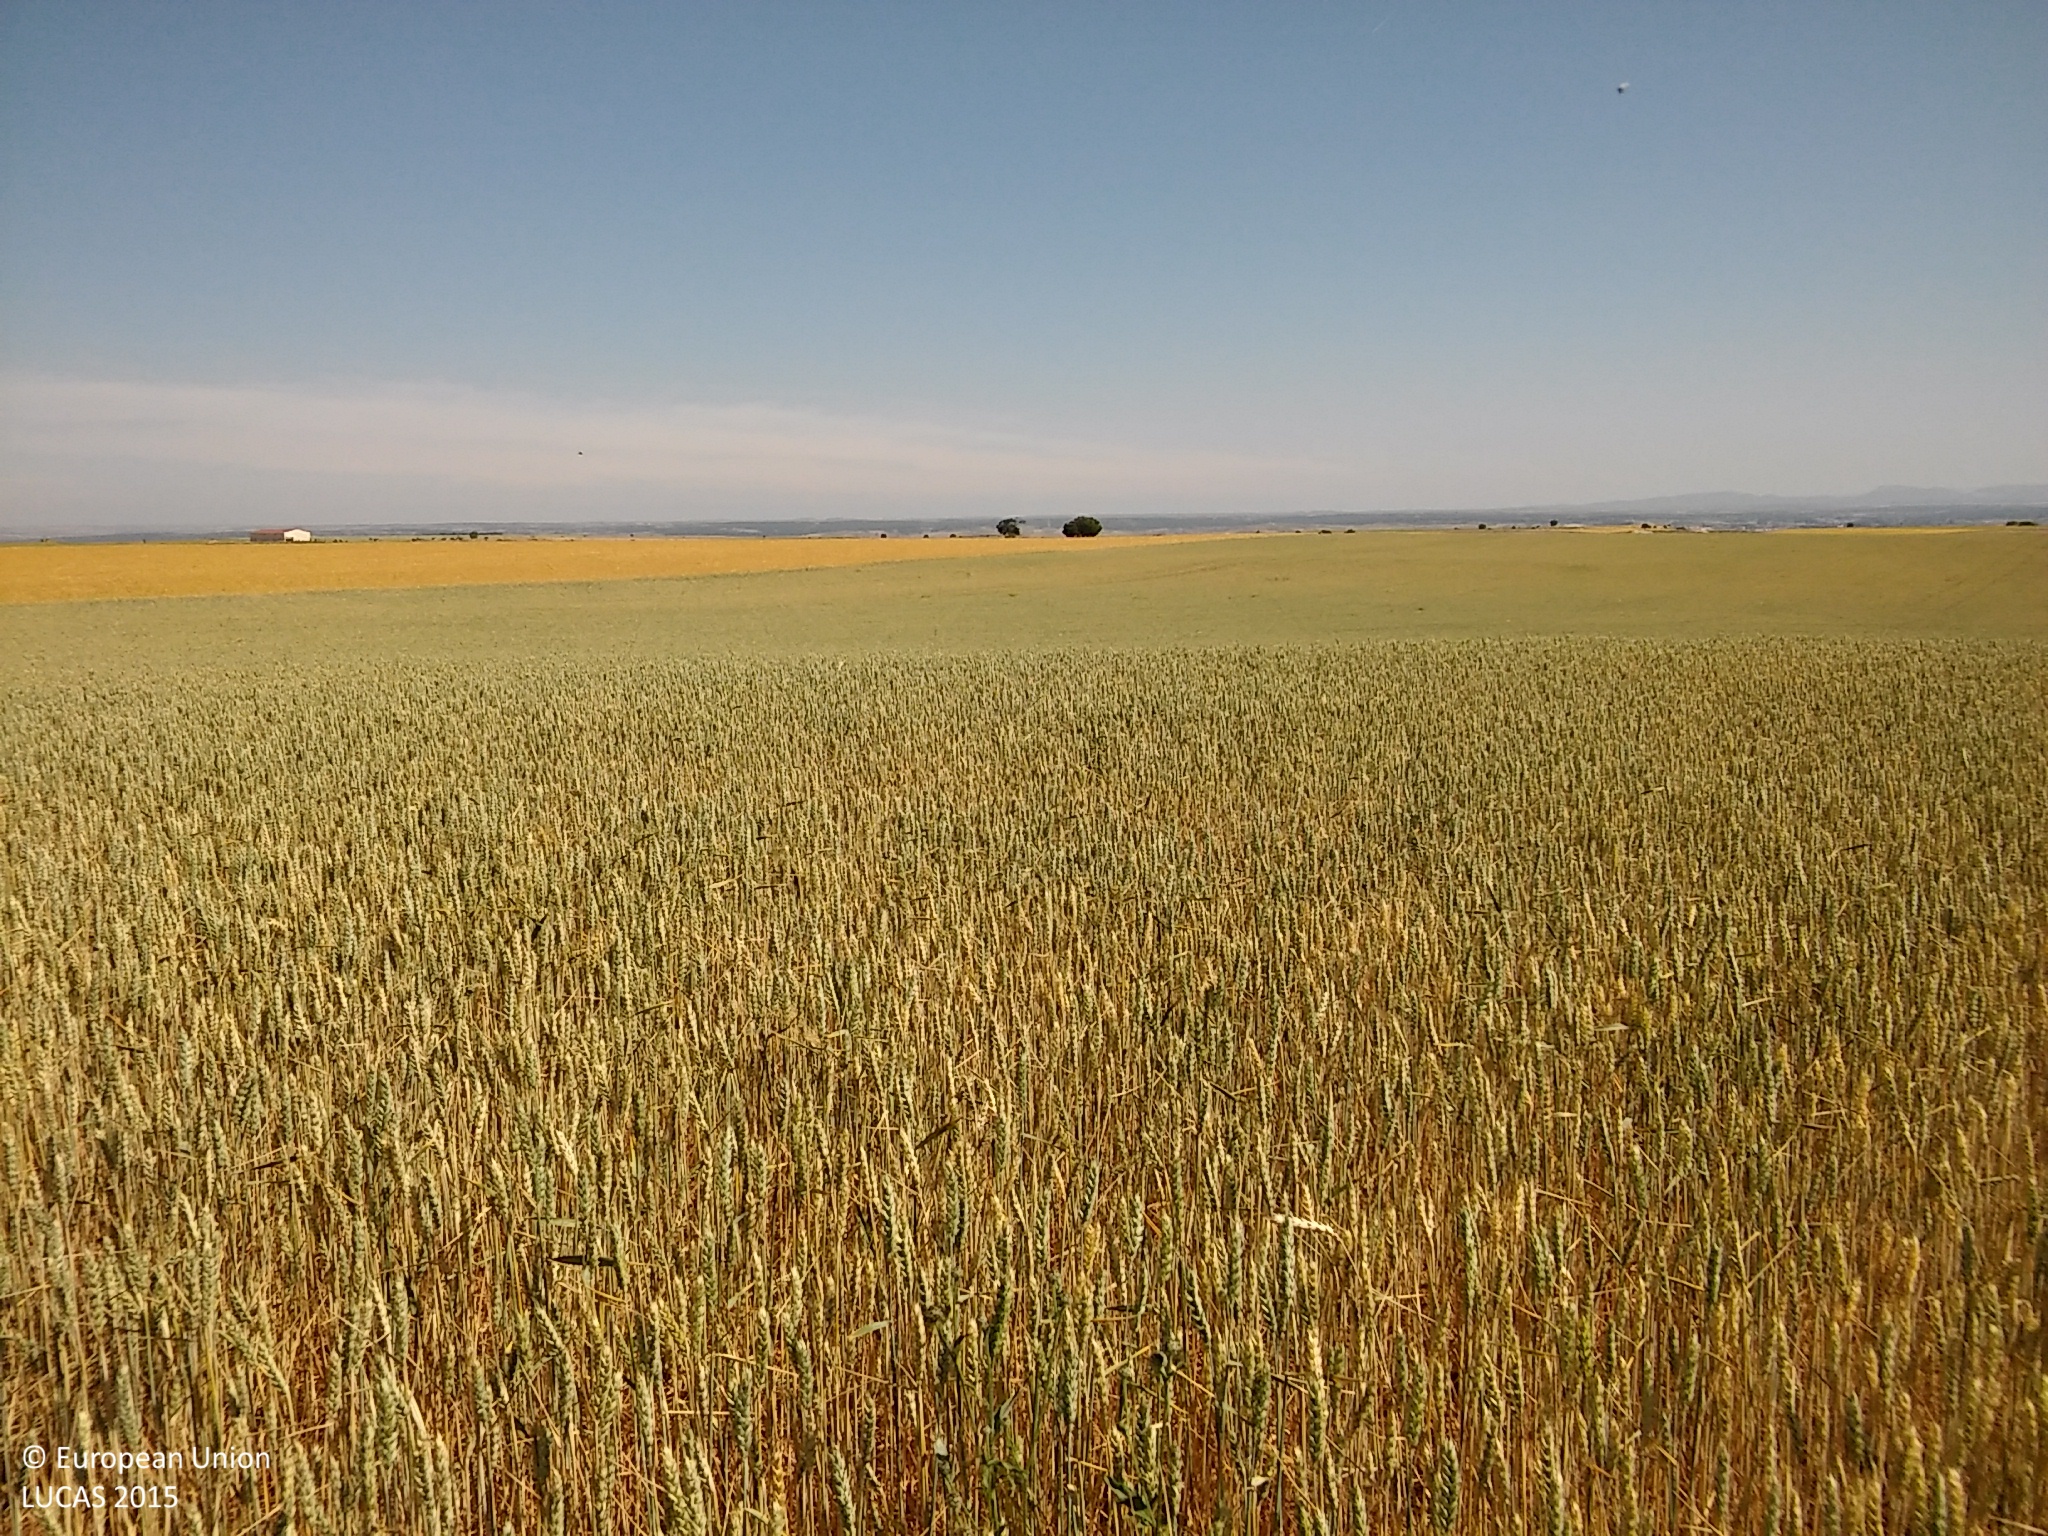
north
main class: Cropland
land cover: Common wheat
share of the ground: 50 - 75 %
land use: Agriculture (excluding fallow land and kitchen gardens)
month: June
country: ES
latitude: 41.6057
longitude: -3.7193
